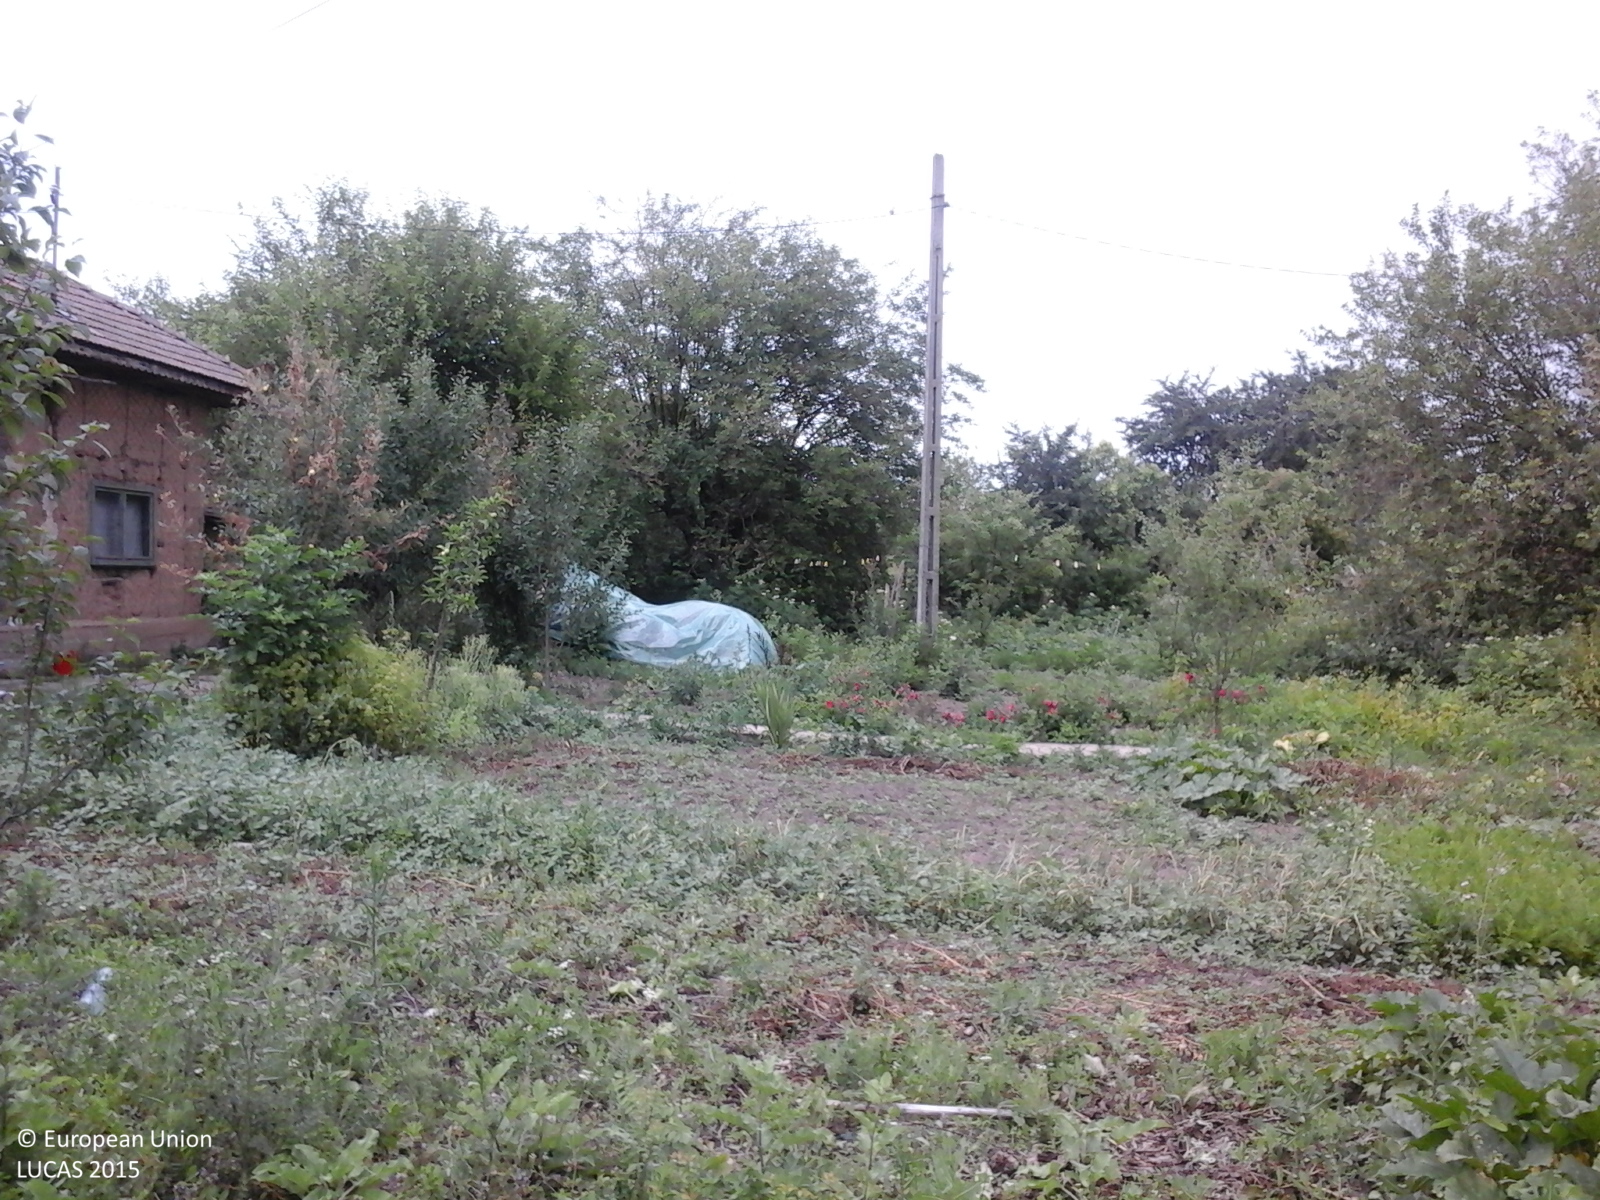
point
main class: Cropland
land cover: Other fresh vegetables
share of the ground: > 75 %
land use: Kitchen garden
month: July
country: RO
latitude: 44.1060
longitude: 24.8027
